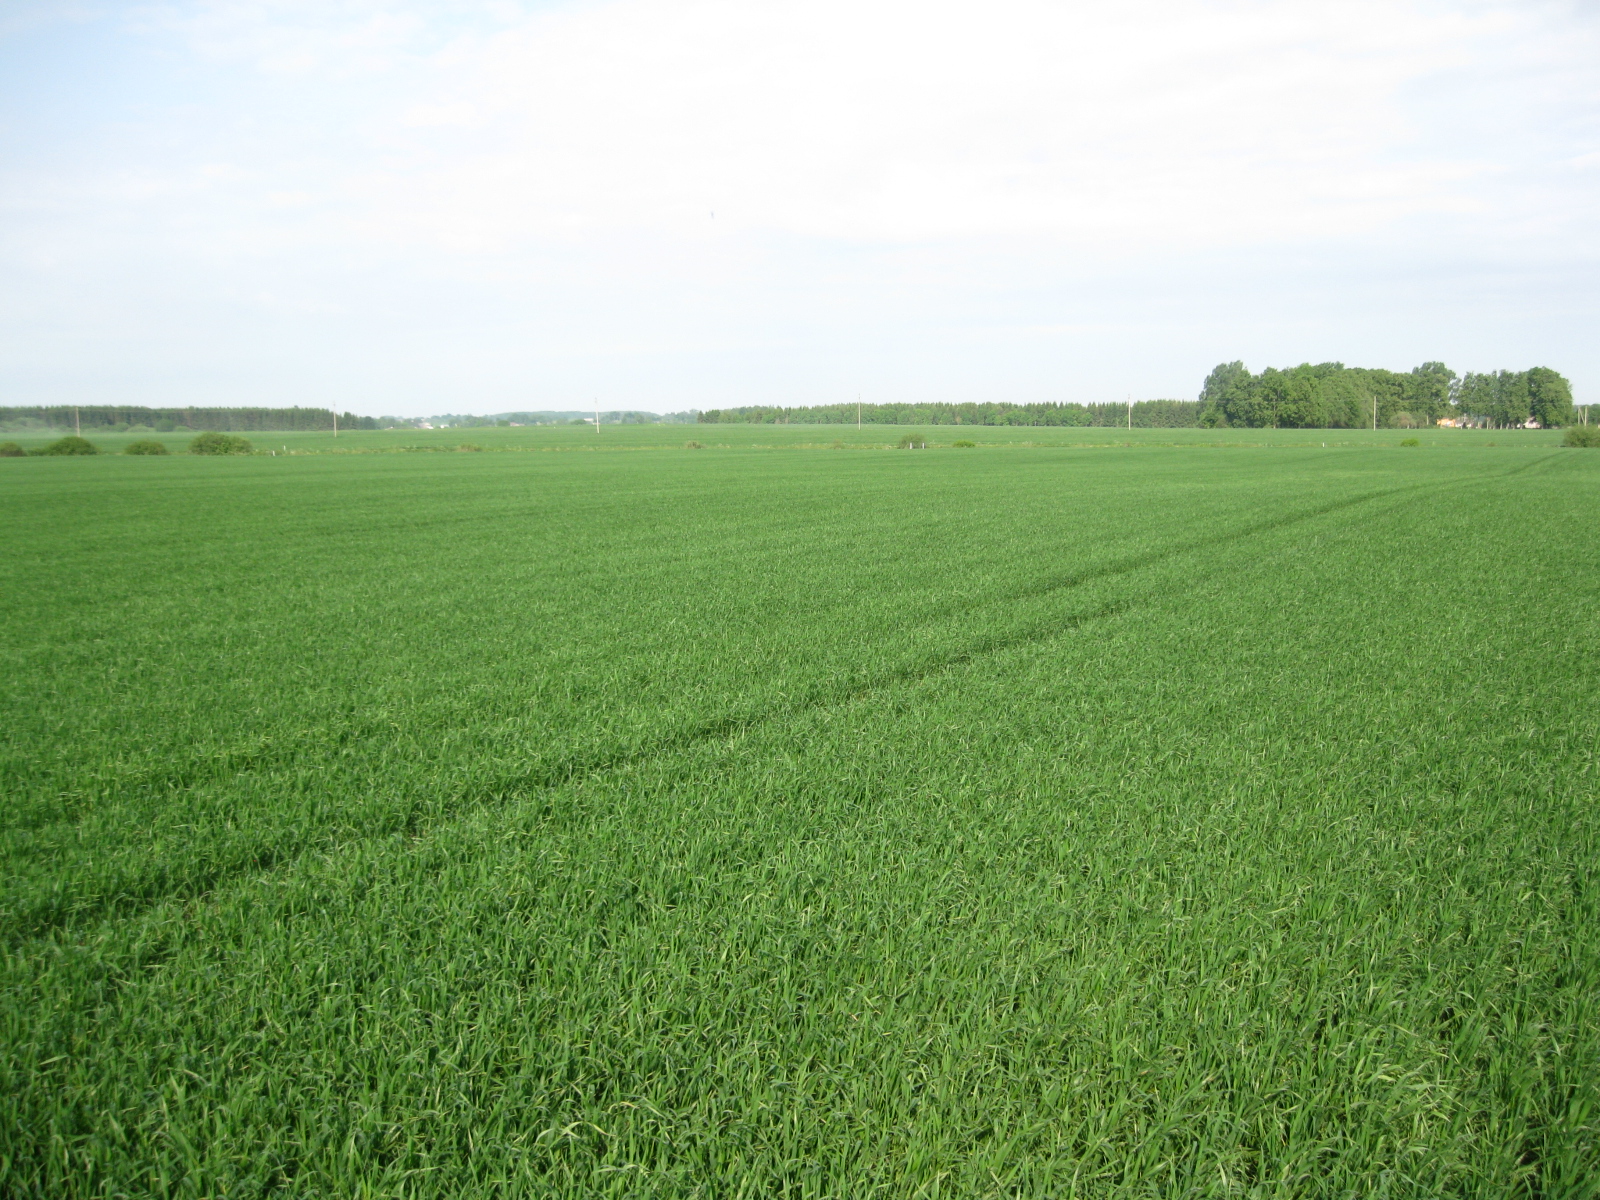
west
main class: Cropland
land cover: Common wheat
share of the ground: > 75 %
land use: Agriculture (excluding fallow land and kitchen gardens)
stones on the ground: < 10 %
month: June
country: LT
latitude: 55.7966
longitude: 23.6878
